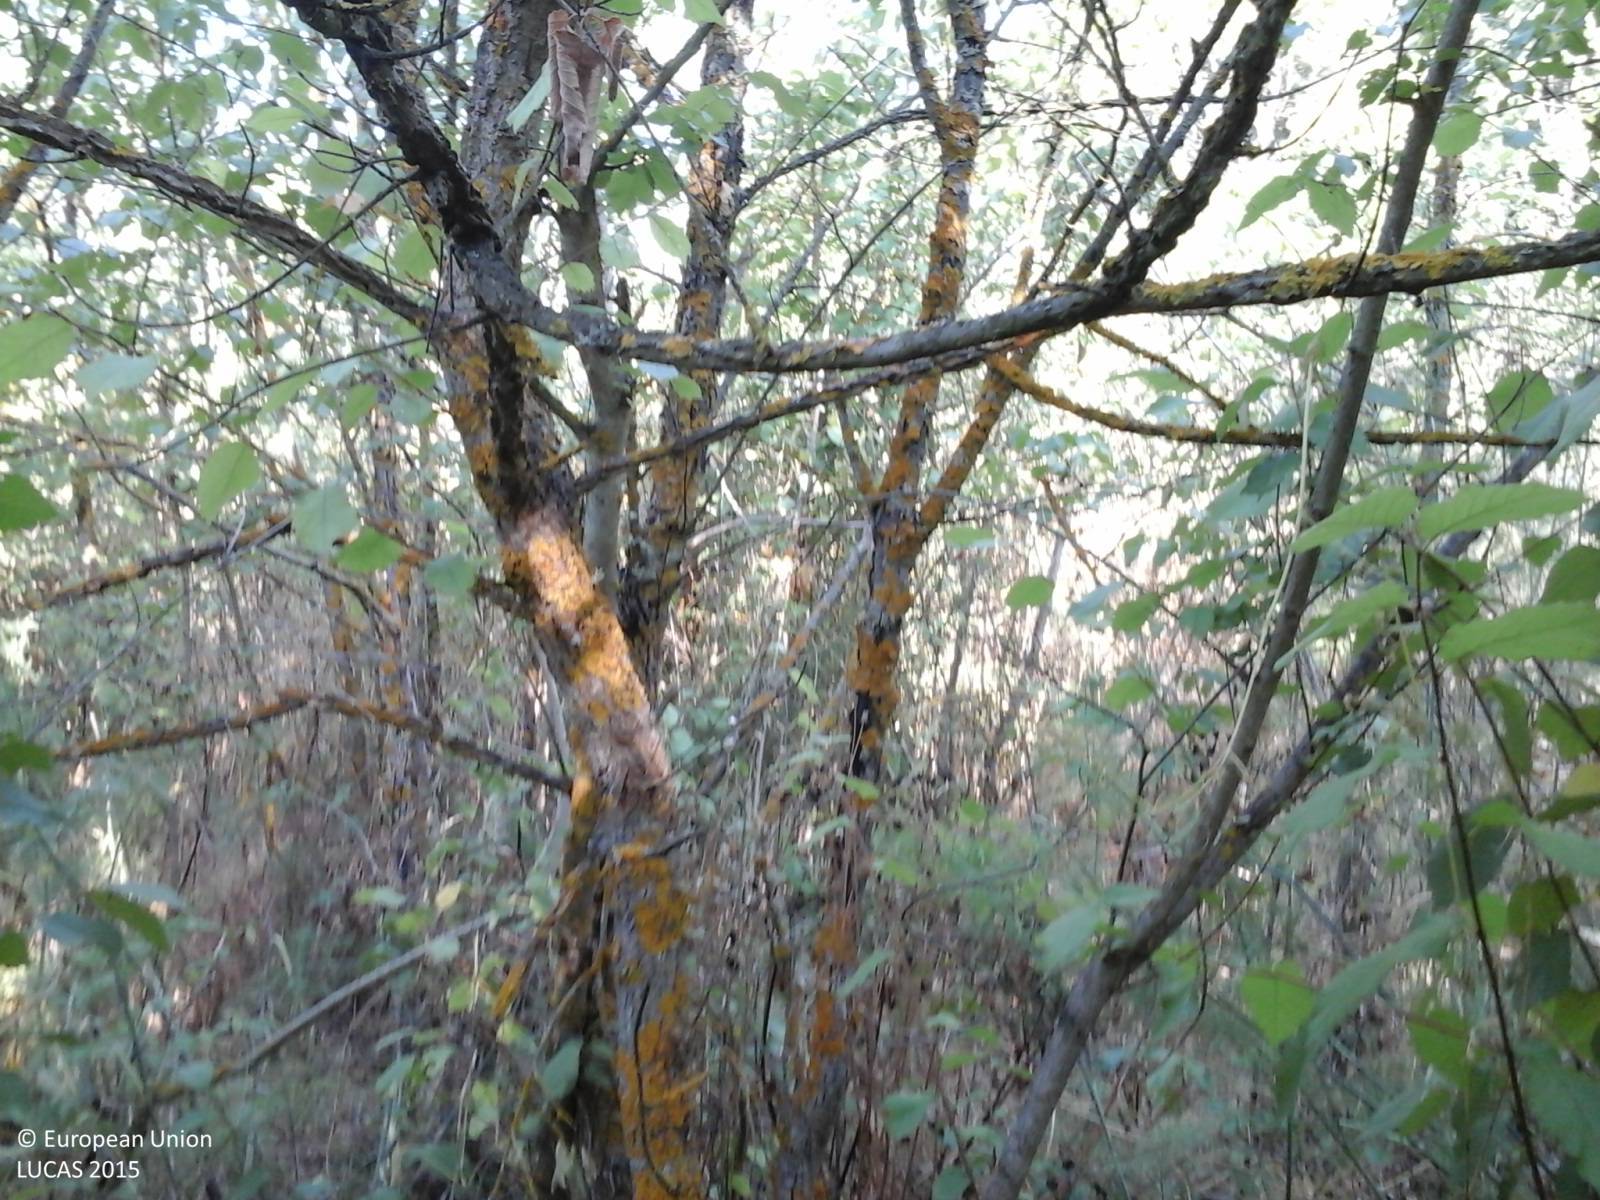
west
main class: Shrubland
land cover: Shrubland with sparse tree cover
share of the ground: > 75 %
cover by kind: shrubs 45 %, herbaceous plants 45 %, broadleaved forest trees 5 %
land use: Semi-natural and natural areas not in use
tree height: < 5 m
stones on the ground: < 10 %
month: June
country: IT
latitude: 40.6746
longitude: 8.6696
